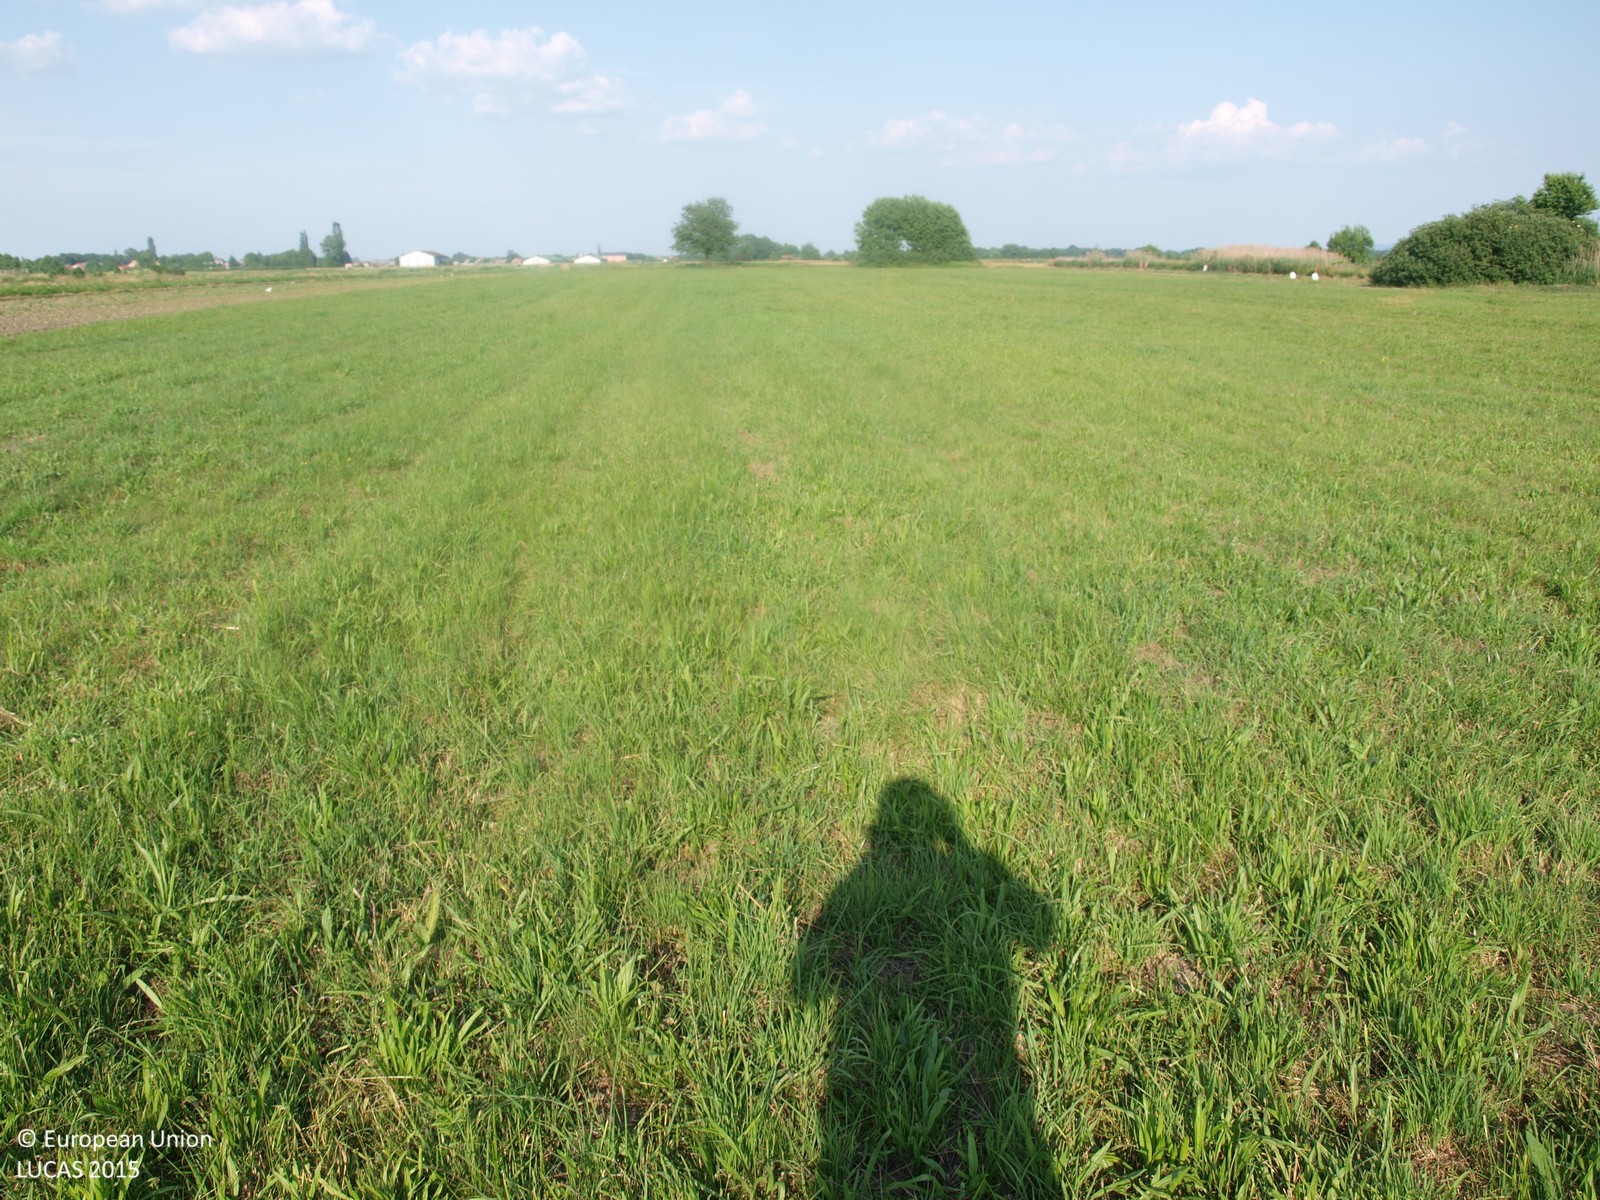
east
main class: Grassland
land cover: Grassland without tree/shrub cover
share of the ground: > 75 %
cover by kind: herbaceous plants 100 %
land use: Agriculture (excluding fallow land and kitchen gardens)
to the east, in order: Grassland without tree/shrub cover; Single bushes/trees; Potatoes
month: June
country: HR
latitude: 46.2773
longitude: 16.2419
